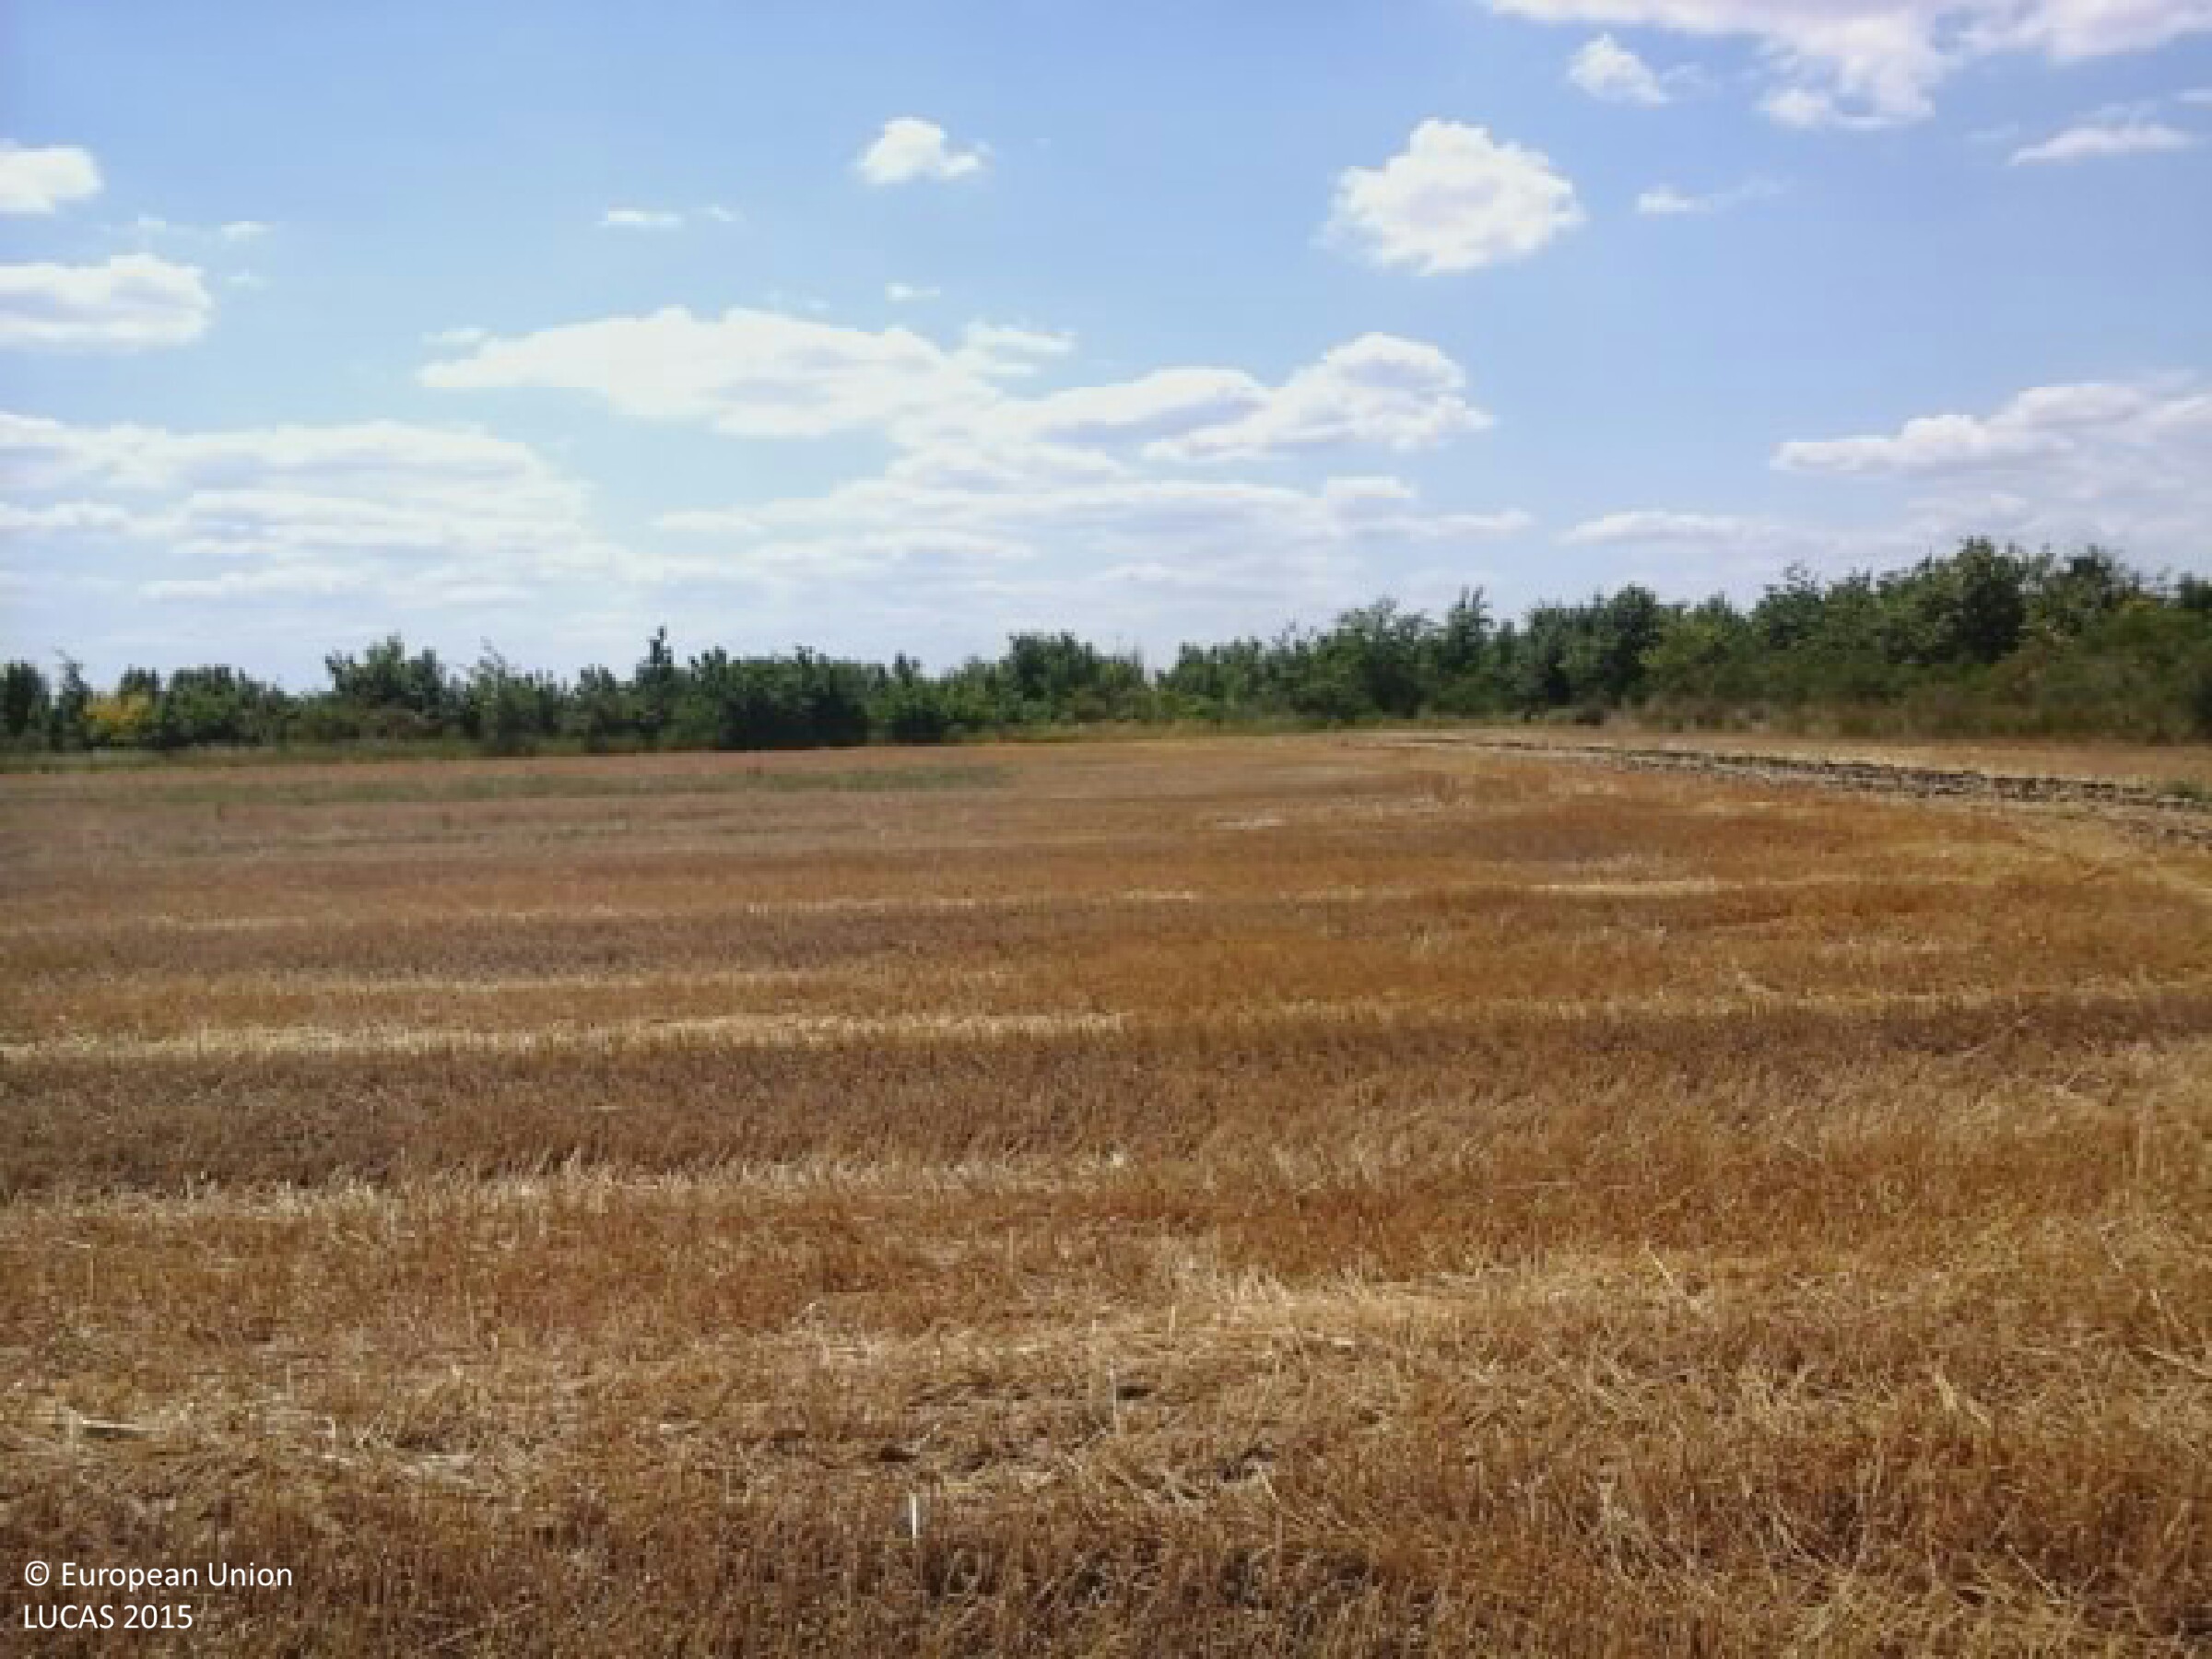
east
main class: Cropland
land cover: Common wheat
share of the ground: < 10 %
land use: Agriculture (excluding fallow land and kitchen gardens)
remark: Harvested field
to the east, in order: Common wheat
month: July
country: HU
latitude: 47.6168
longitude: 20.4485
